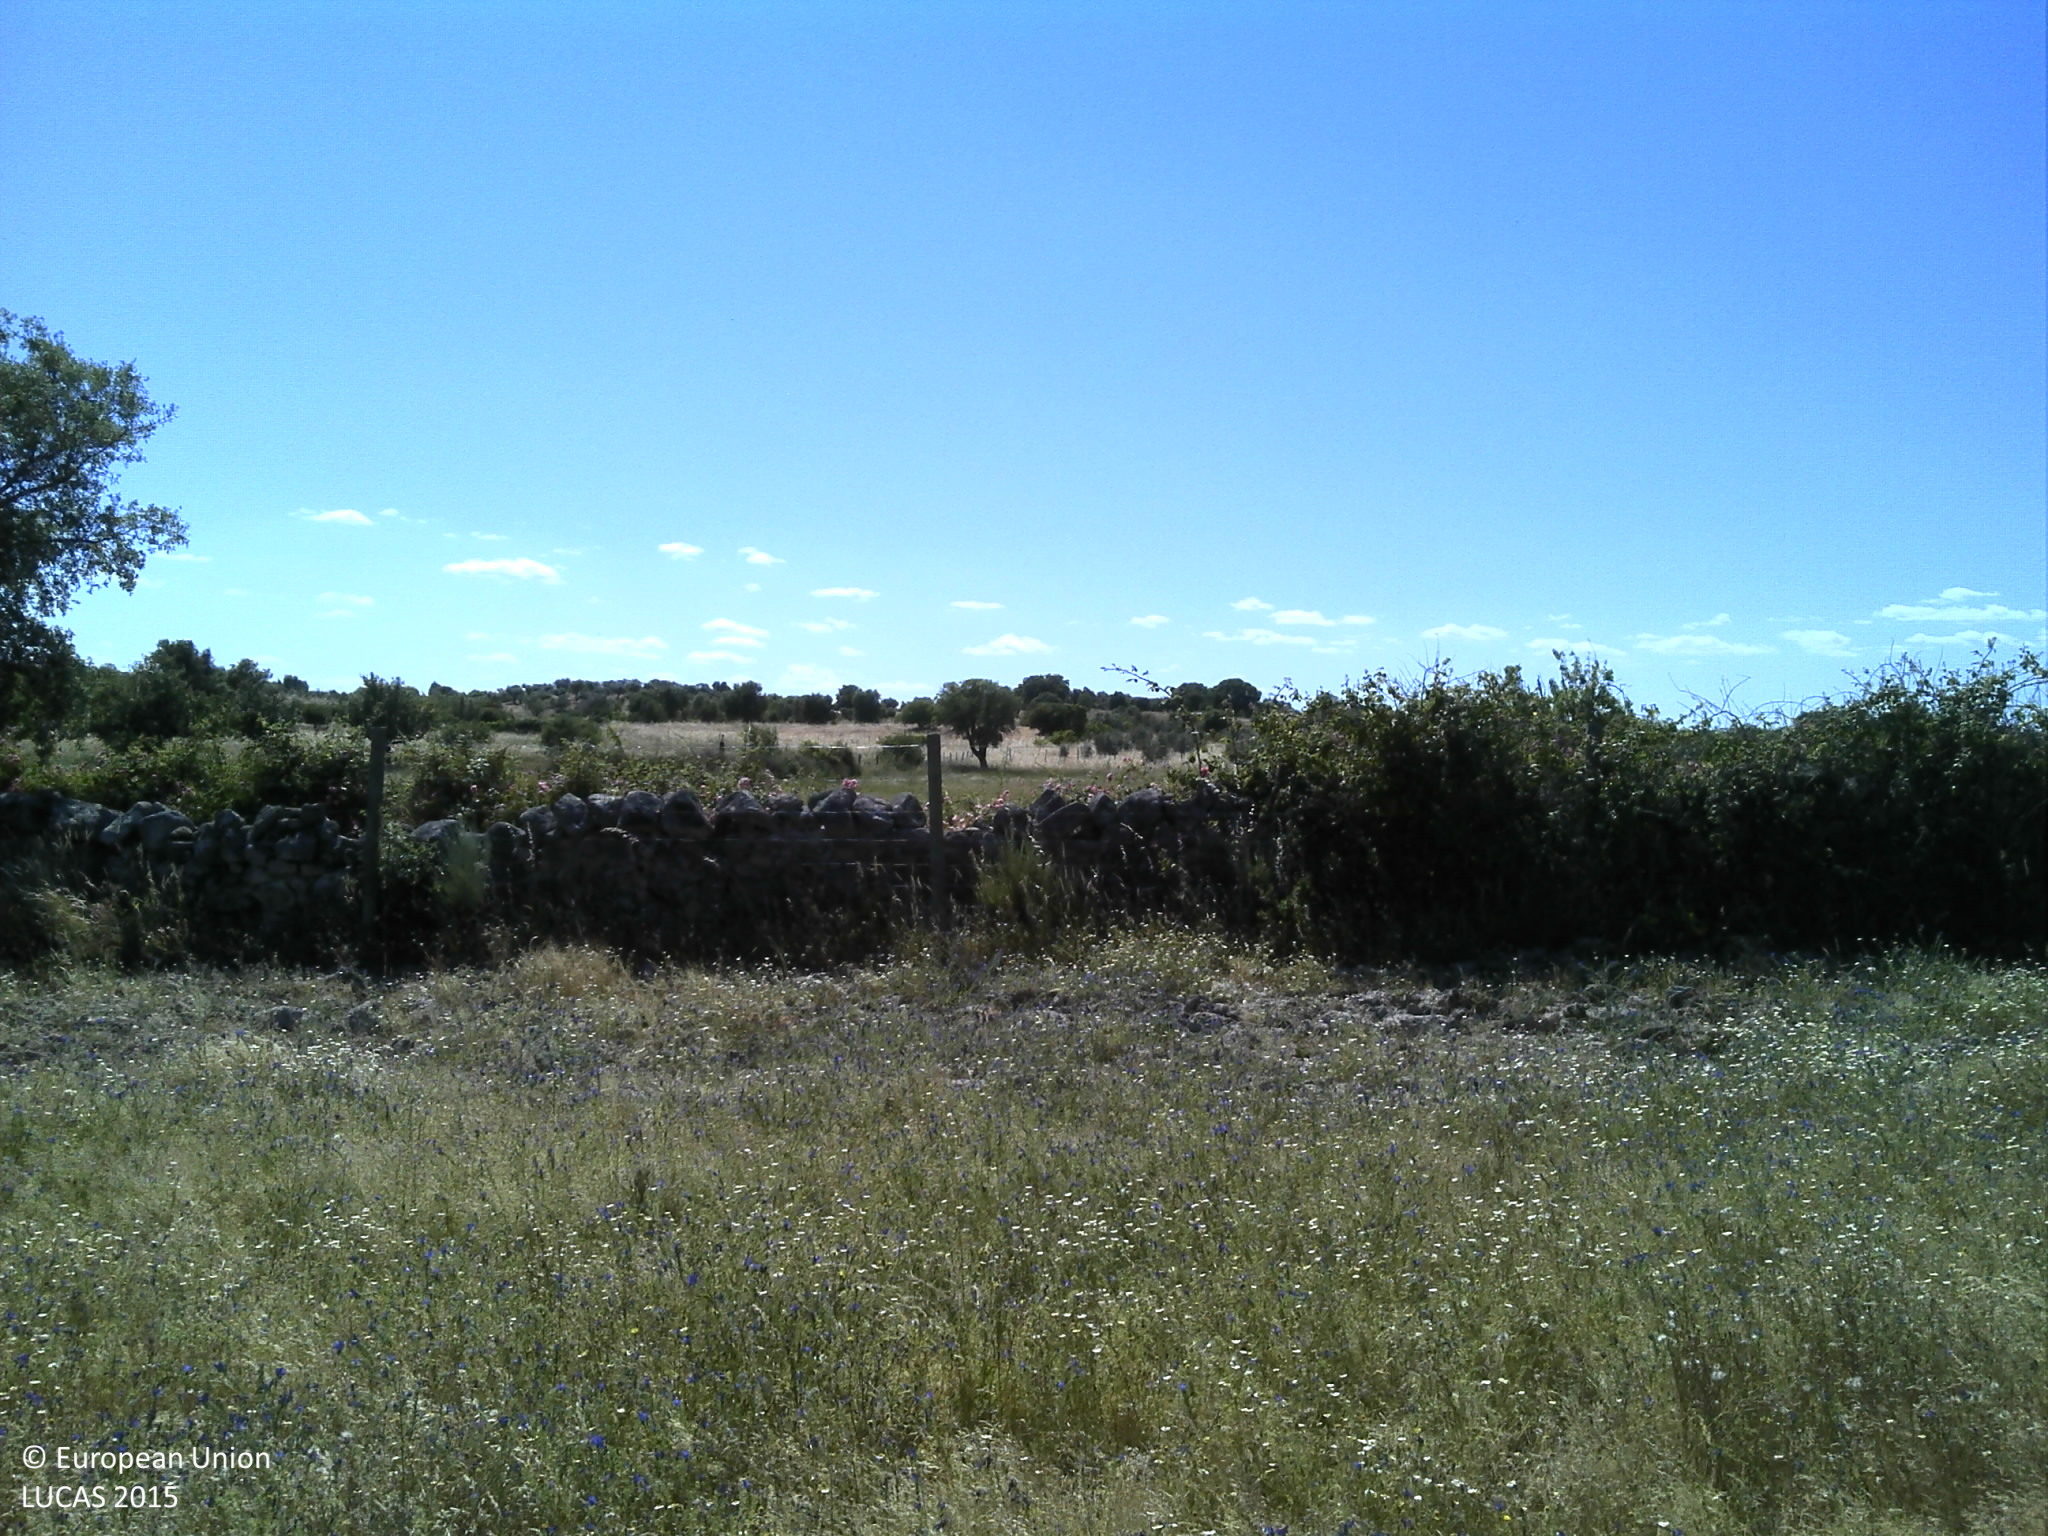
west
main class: Grassland
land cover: Grassland without tree/shrub cover
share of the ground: > 75 %
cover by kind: herbaceous plants 90 %, unconsolidated bare surface 10 %
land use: Agriculture (excluding fallow land and kitchen gardens)
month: May
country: PT
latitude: 39.3985
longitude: -7.7121
